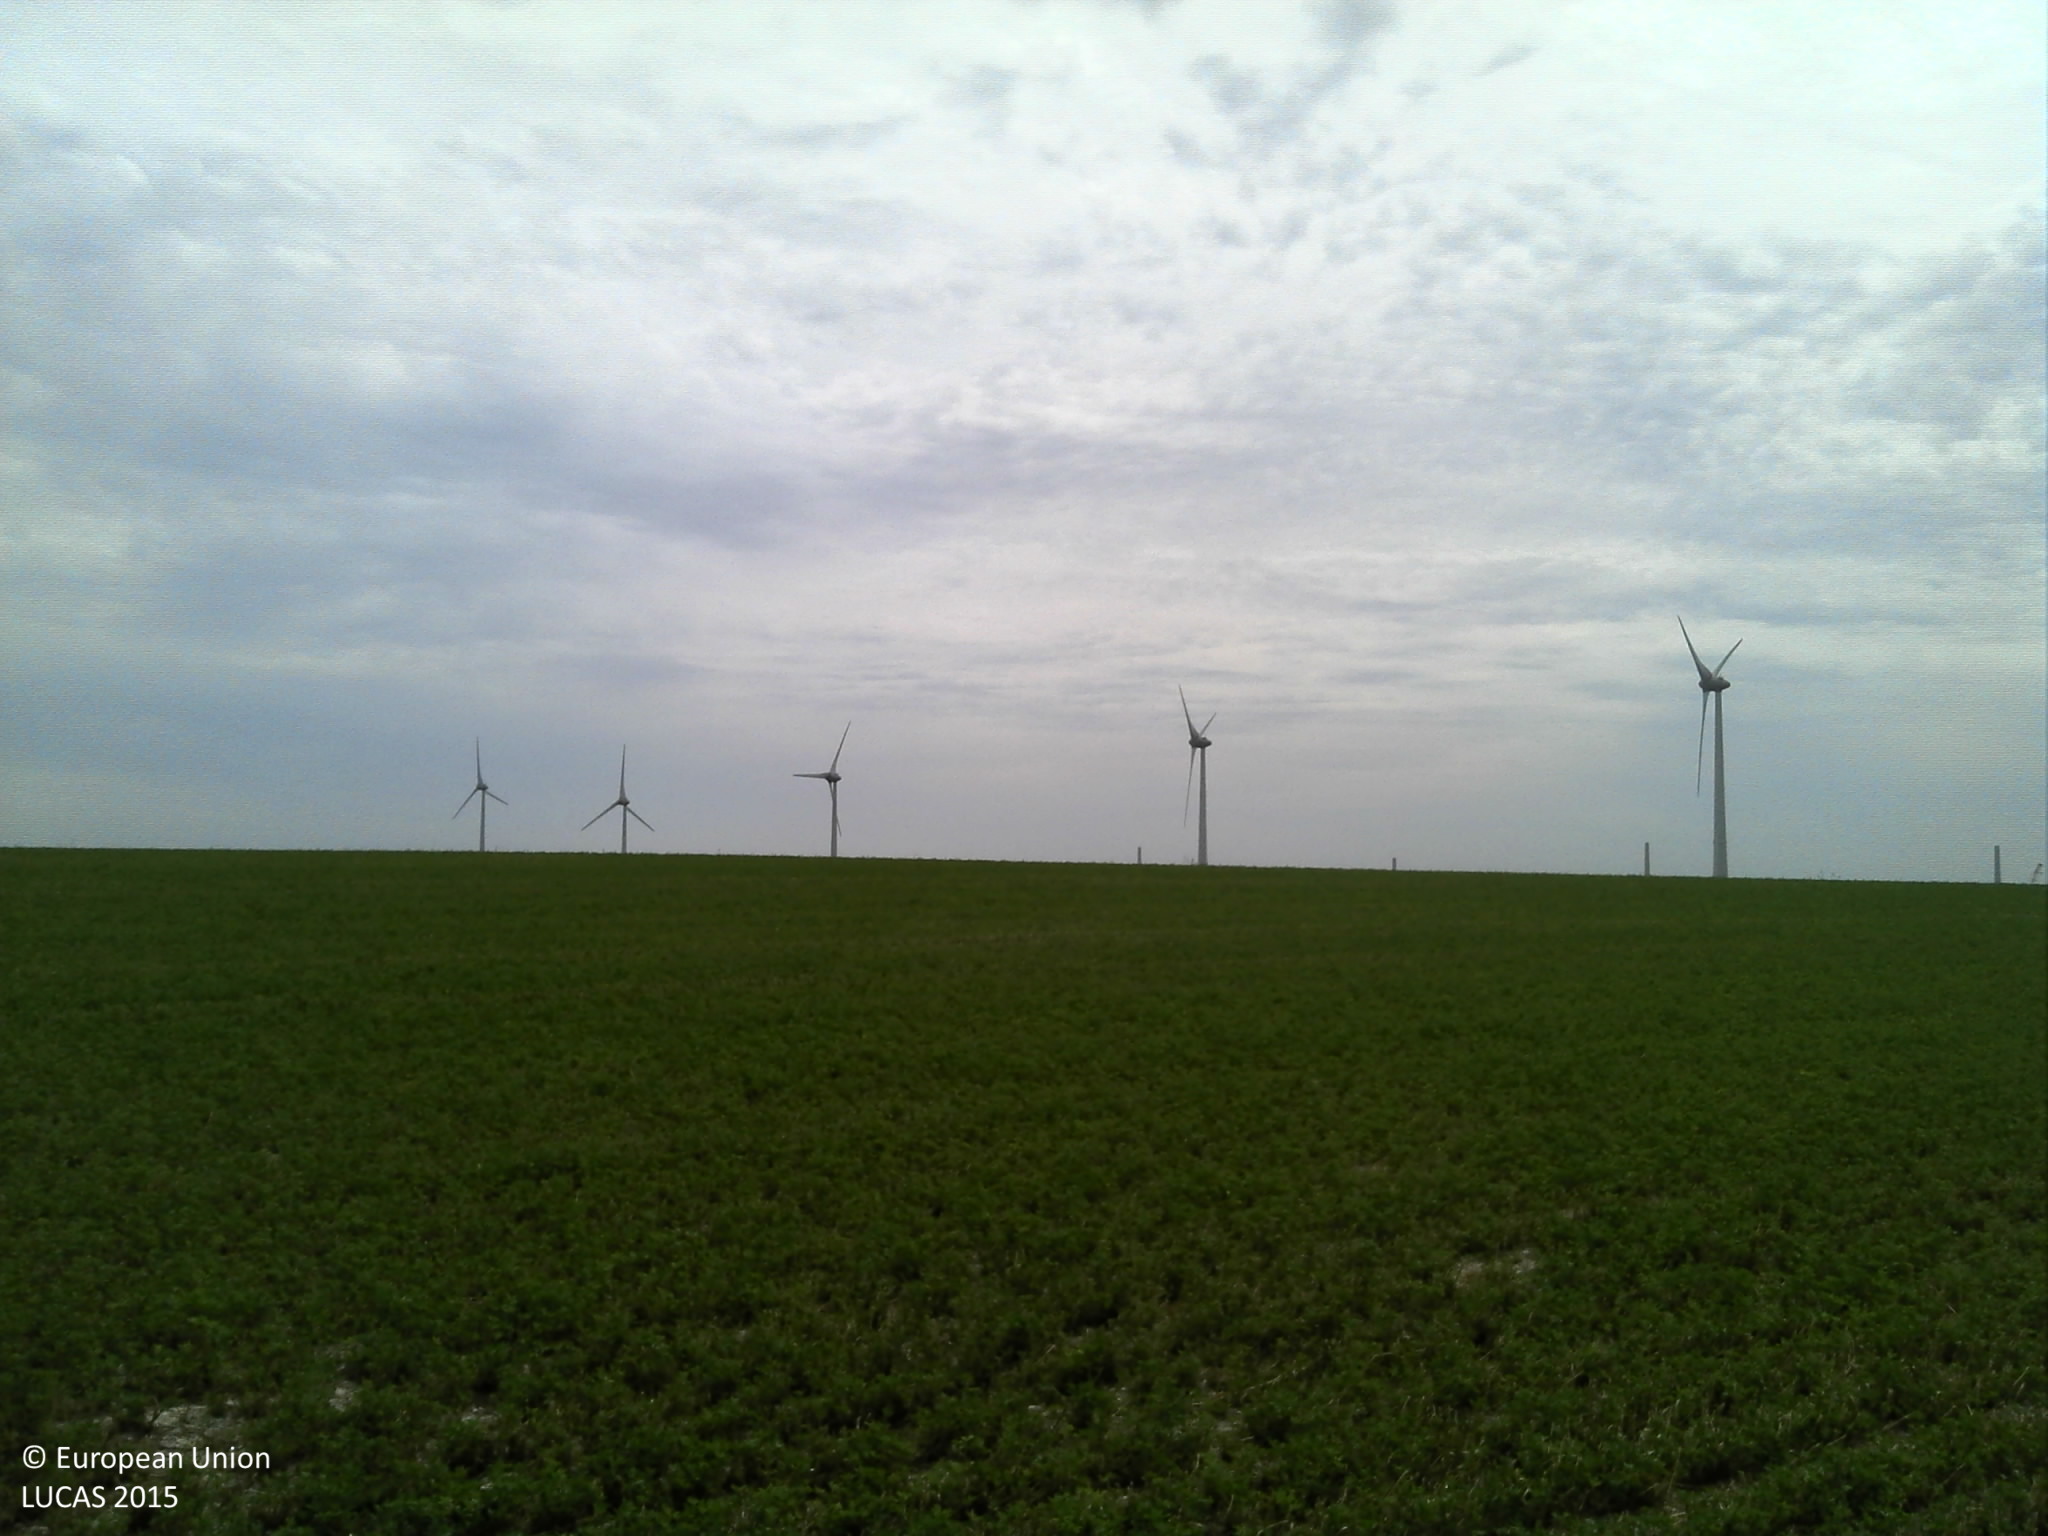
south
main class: Cropland
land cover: Lucerne
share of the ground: > 75 %
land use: Agriculture (excluding fallow land and kitchen gardens)
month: July
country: FR
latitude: 49.5707
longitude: 4.2569
